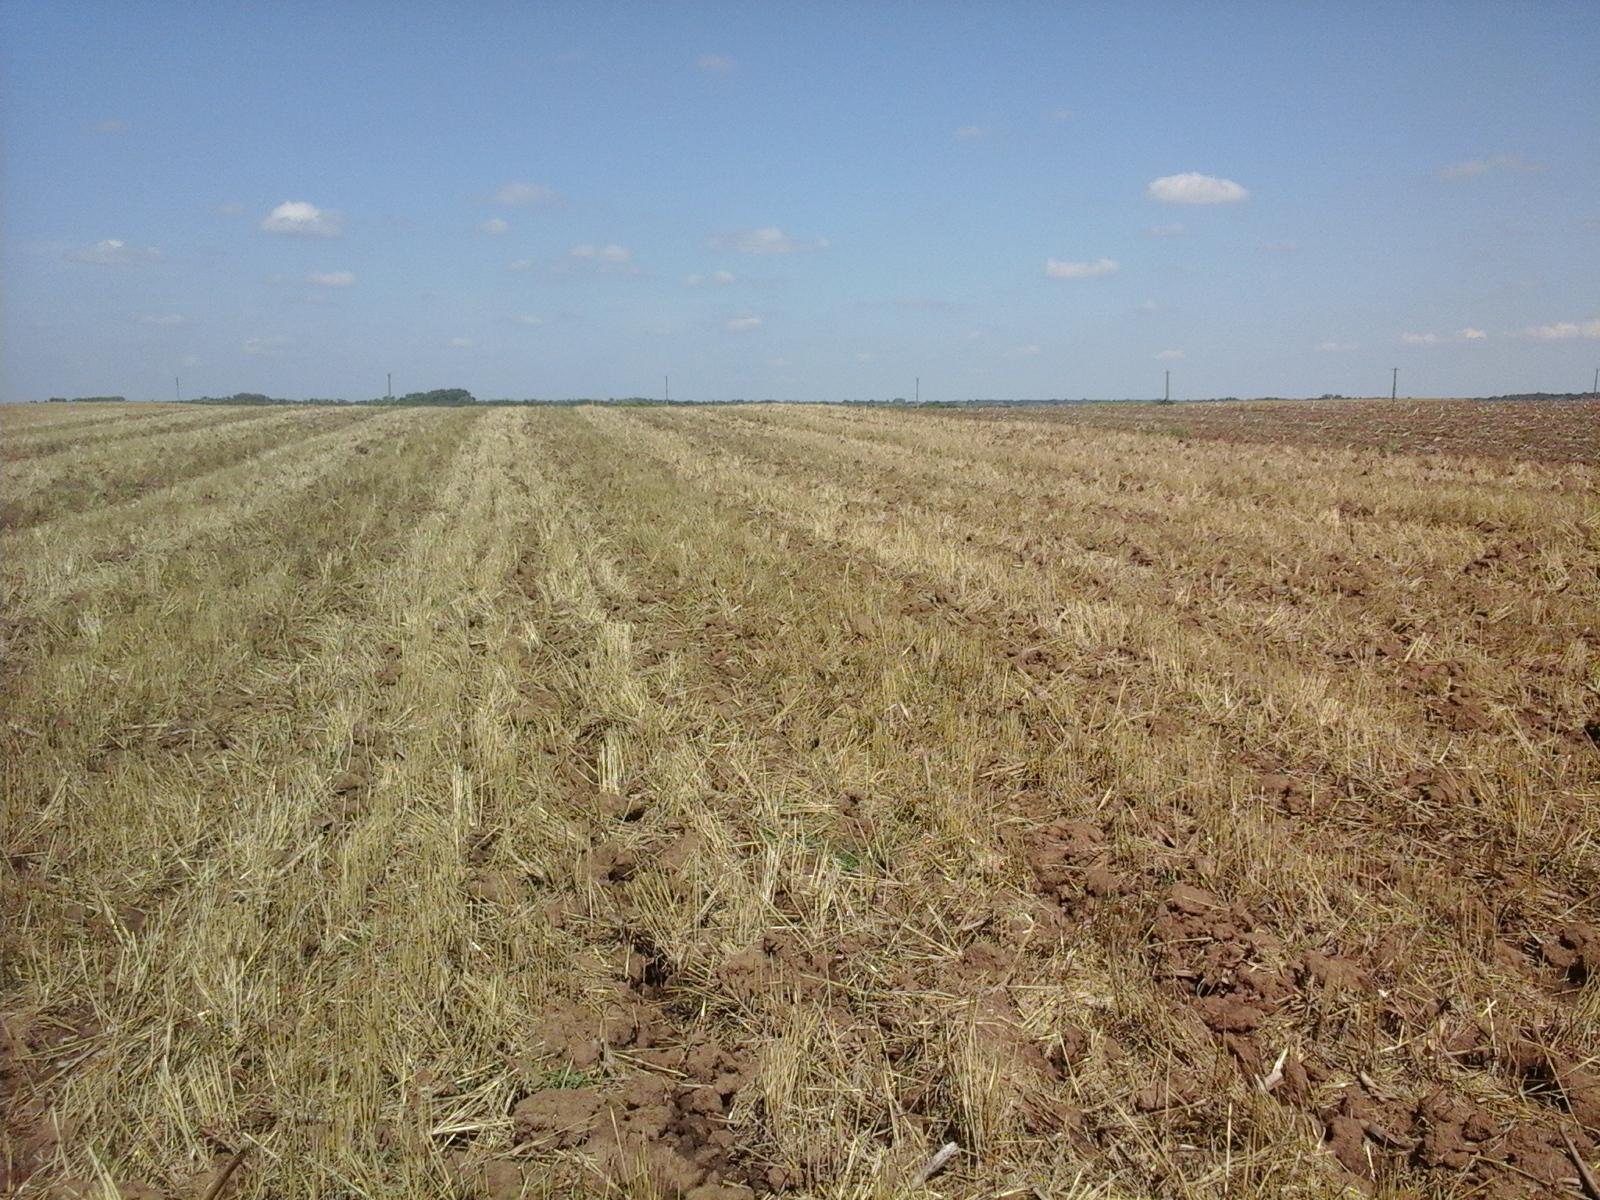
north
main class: Cropland
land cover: Common wheat
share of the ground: 50 - 75 %
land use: Agriculture (excluding fallow land and kitchen gardens)
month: August
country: RO
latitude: 46.1148
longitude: 21.1202
